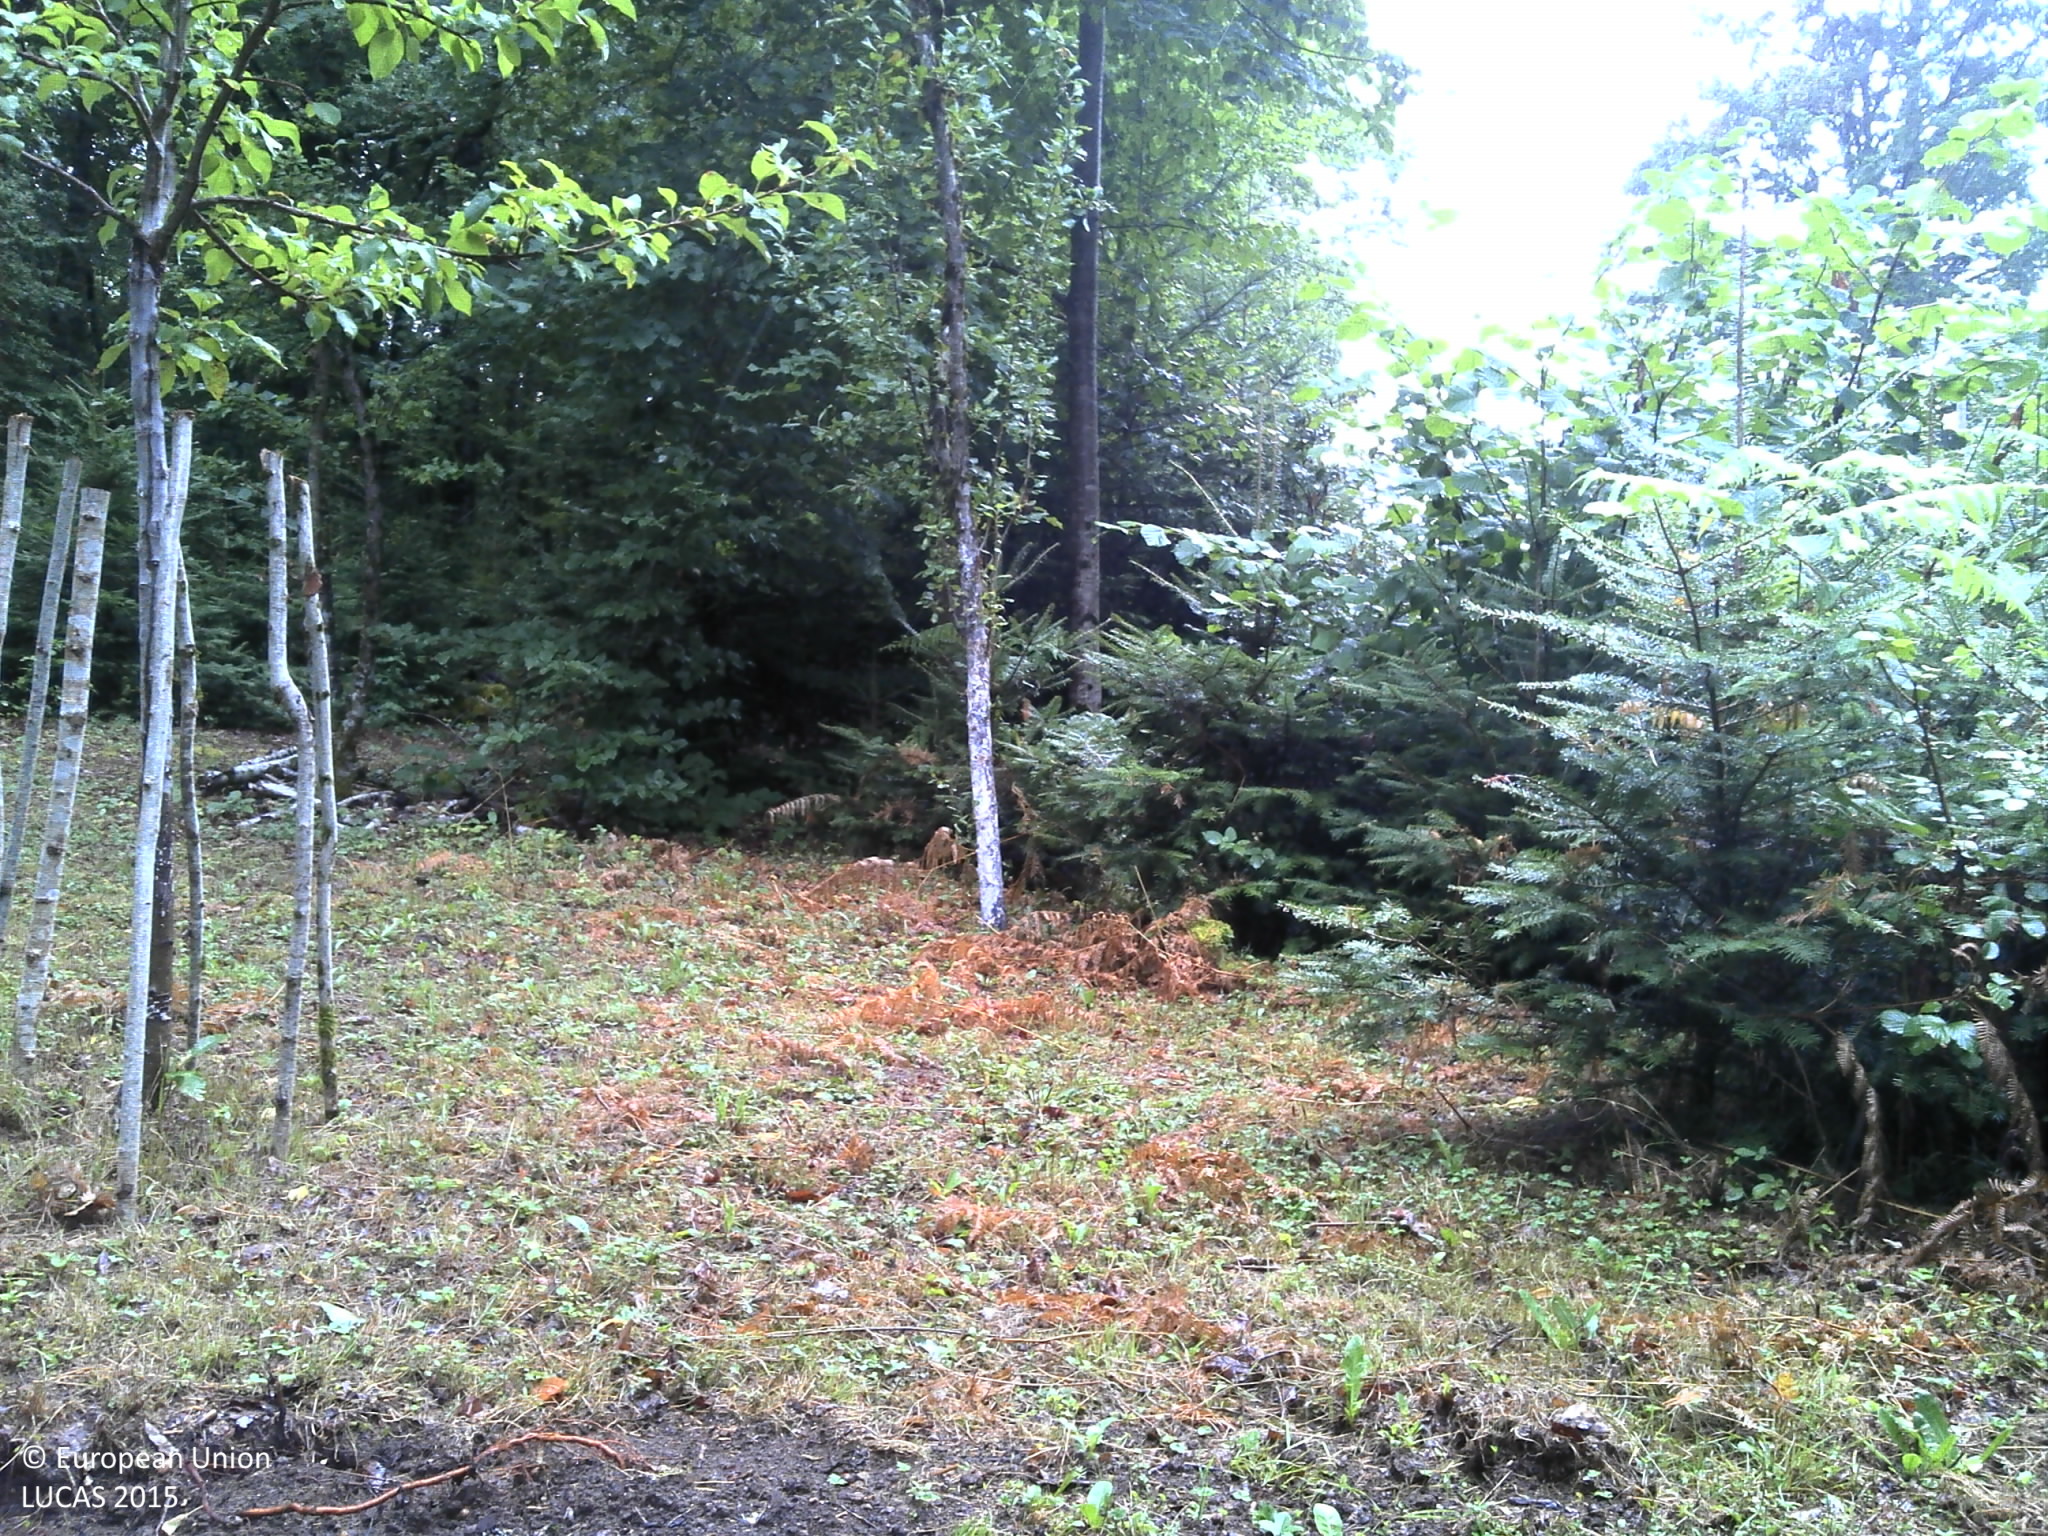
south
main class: Woodland
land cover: Broadleaved woodland
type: acidophilous oak and oak-birch forest
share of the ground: > 75 %
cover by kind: broadleaved forest trees 70 %, unconsolidated bare surface 20 %, herbaceous plants 5 %, lichens and mosses 5 %
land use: Forestry
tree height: > 5 m
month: August
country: FR
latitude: 45.3874
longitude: 2.3221
